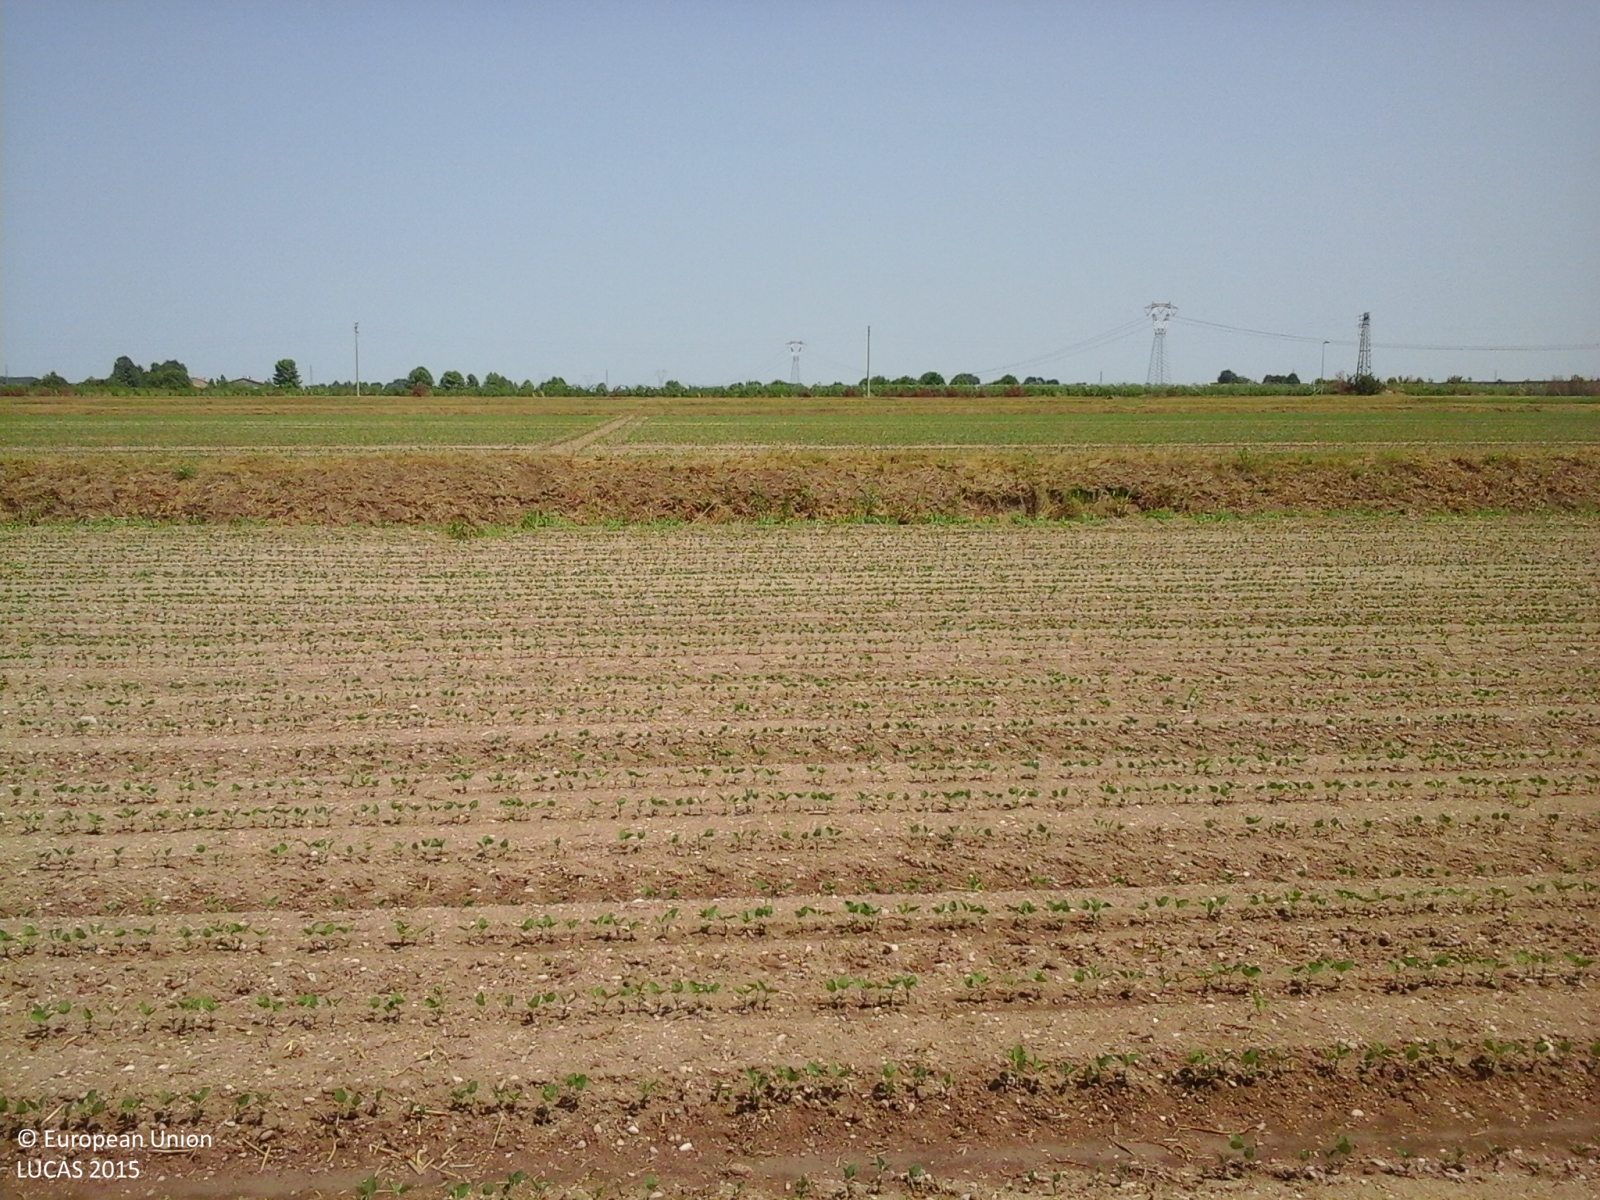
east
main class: Cropland
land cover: Soya
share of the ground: < 10 %
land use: Agriculture (excluding fallow land and kitchen gardens)
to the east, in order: Soya; Ditches and canals; Grass margins; Soya; Ditches and canals; Grass margins; Soya; Ditches and canals; Grass margins; Soya
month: July
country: IT
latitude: 45.3196
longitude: 10.9805
